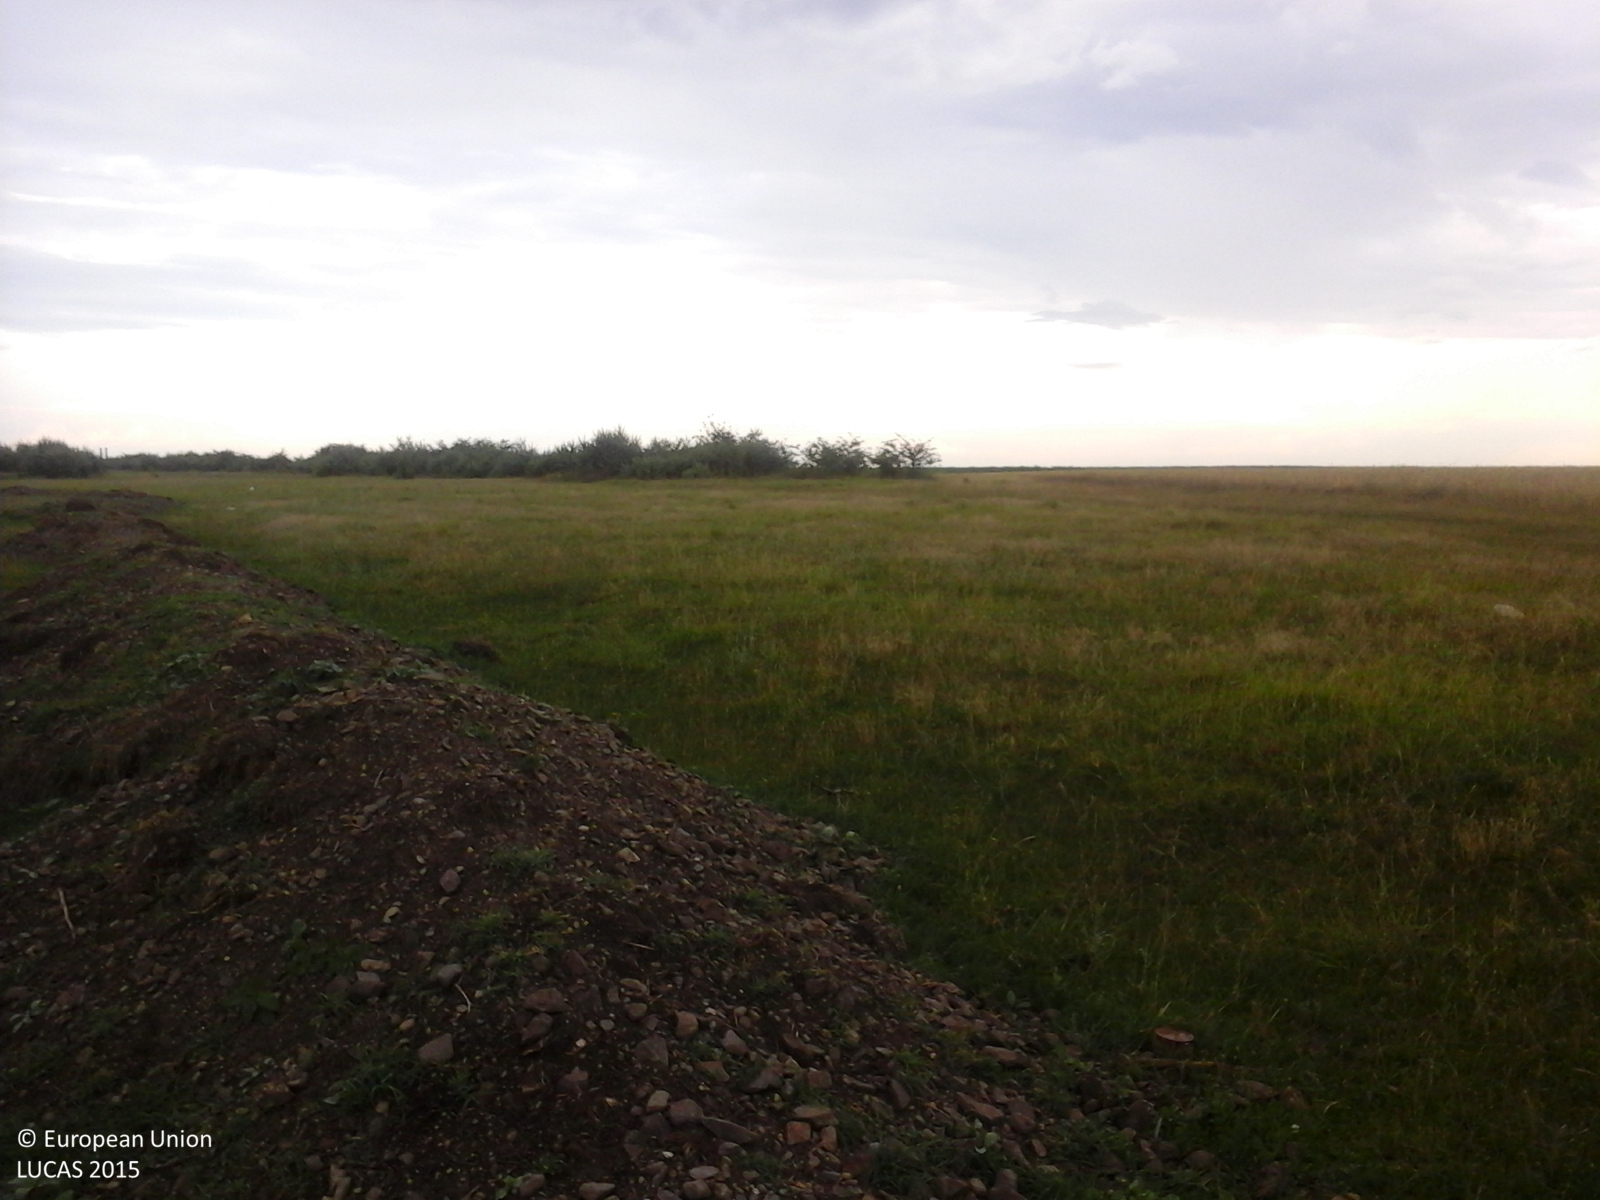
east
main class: Grassland
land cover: Grassland without tree/shrub cover
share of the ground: > 75 %
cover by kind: herbaceous plants 100 %
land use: Agriculture (excluding fallow land and kitchen gardens)
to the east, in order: Grassland without tree/shrub cover; Tracks; Grassland without tree/shrub cover; Shrubland with sparse tree cover
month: July
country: RO
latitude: 44.1094
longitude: 24.9056
